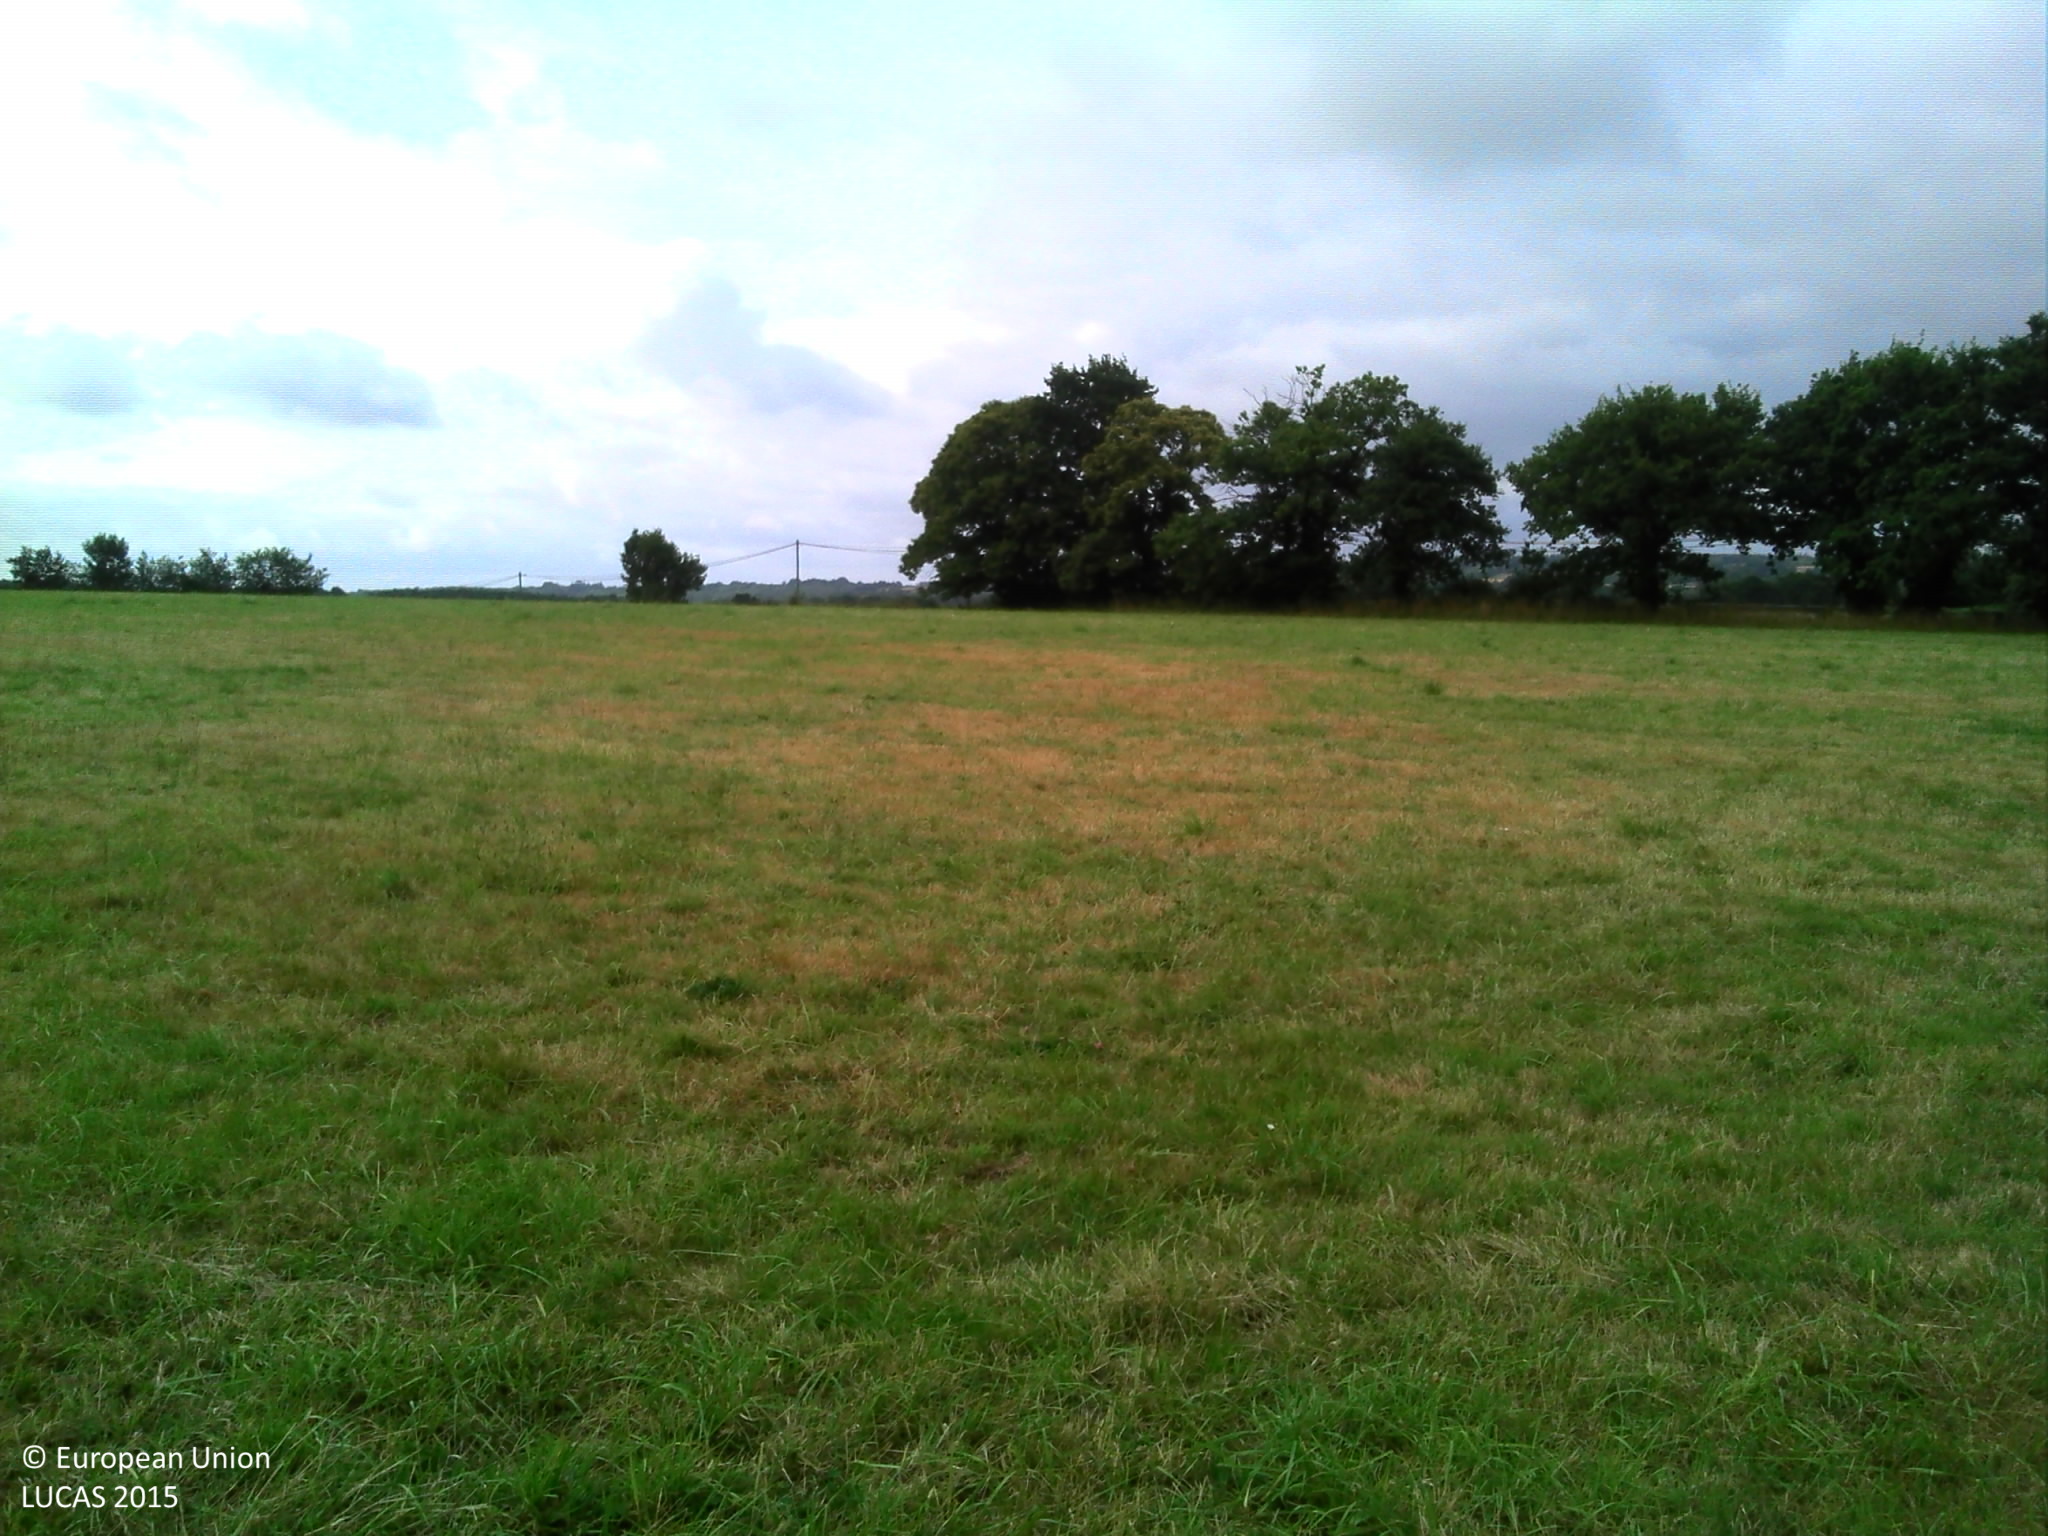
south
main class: Grassland
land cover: Grassland without tree/shrub cover
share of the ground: > 75 %
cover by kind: herbaceous plants 100 %
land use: Agriculture (excluding fallow land and kitchen gardens)
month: July
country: FR
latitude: 47.5654
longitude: -1.9991
